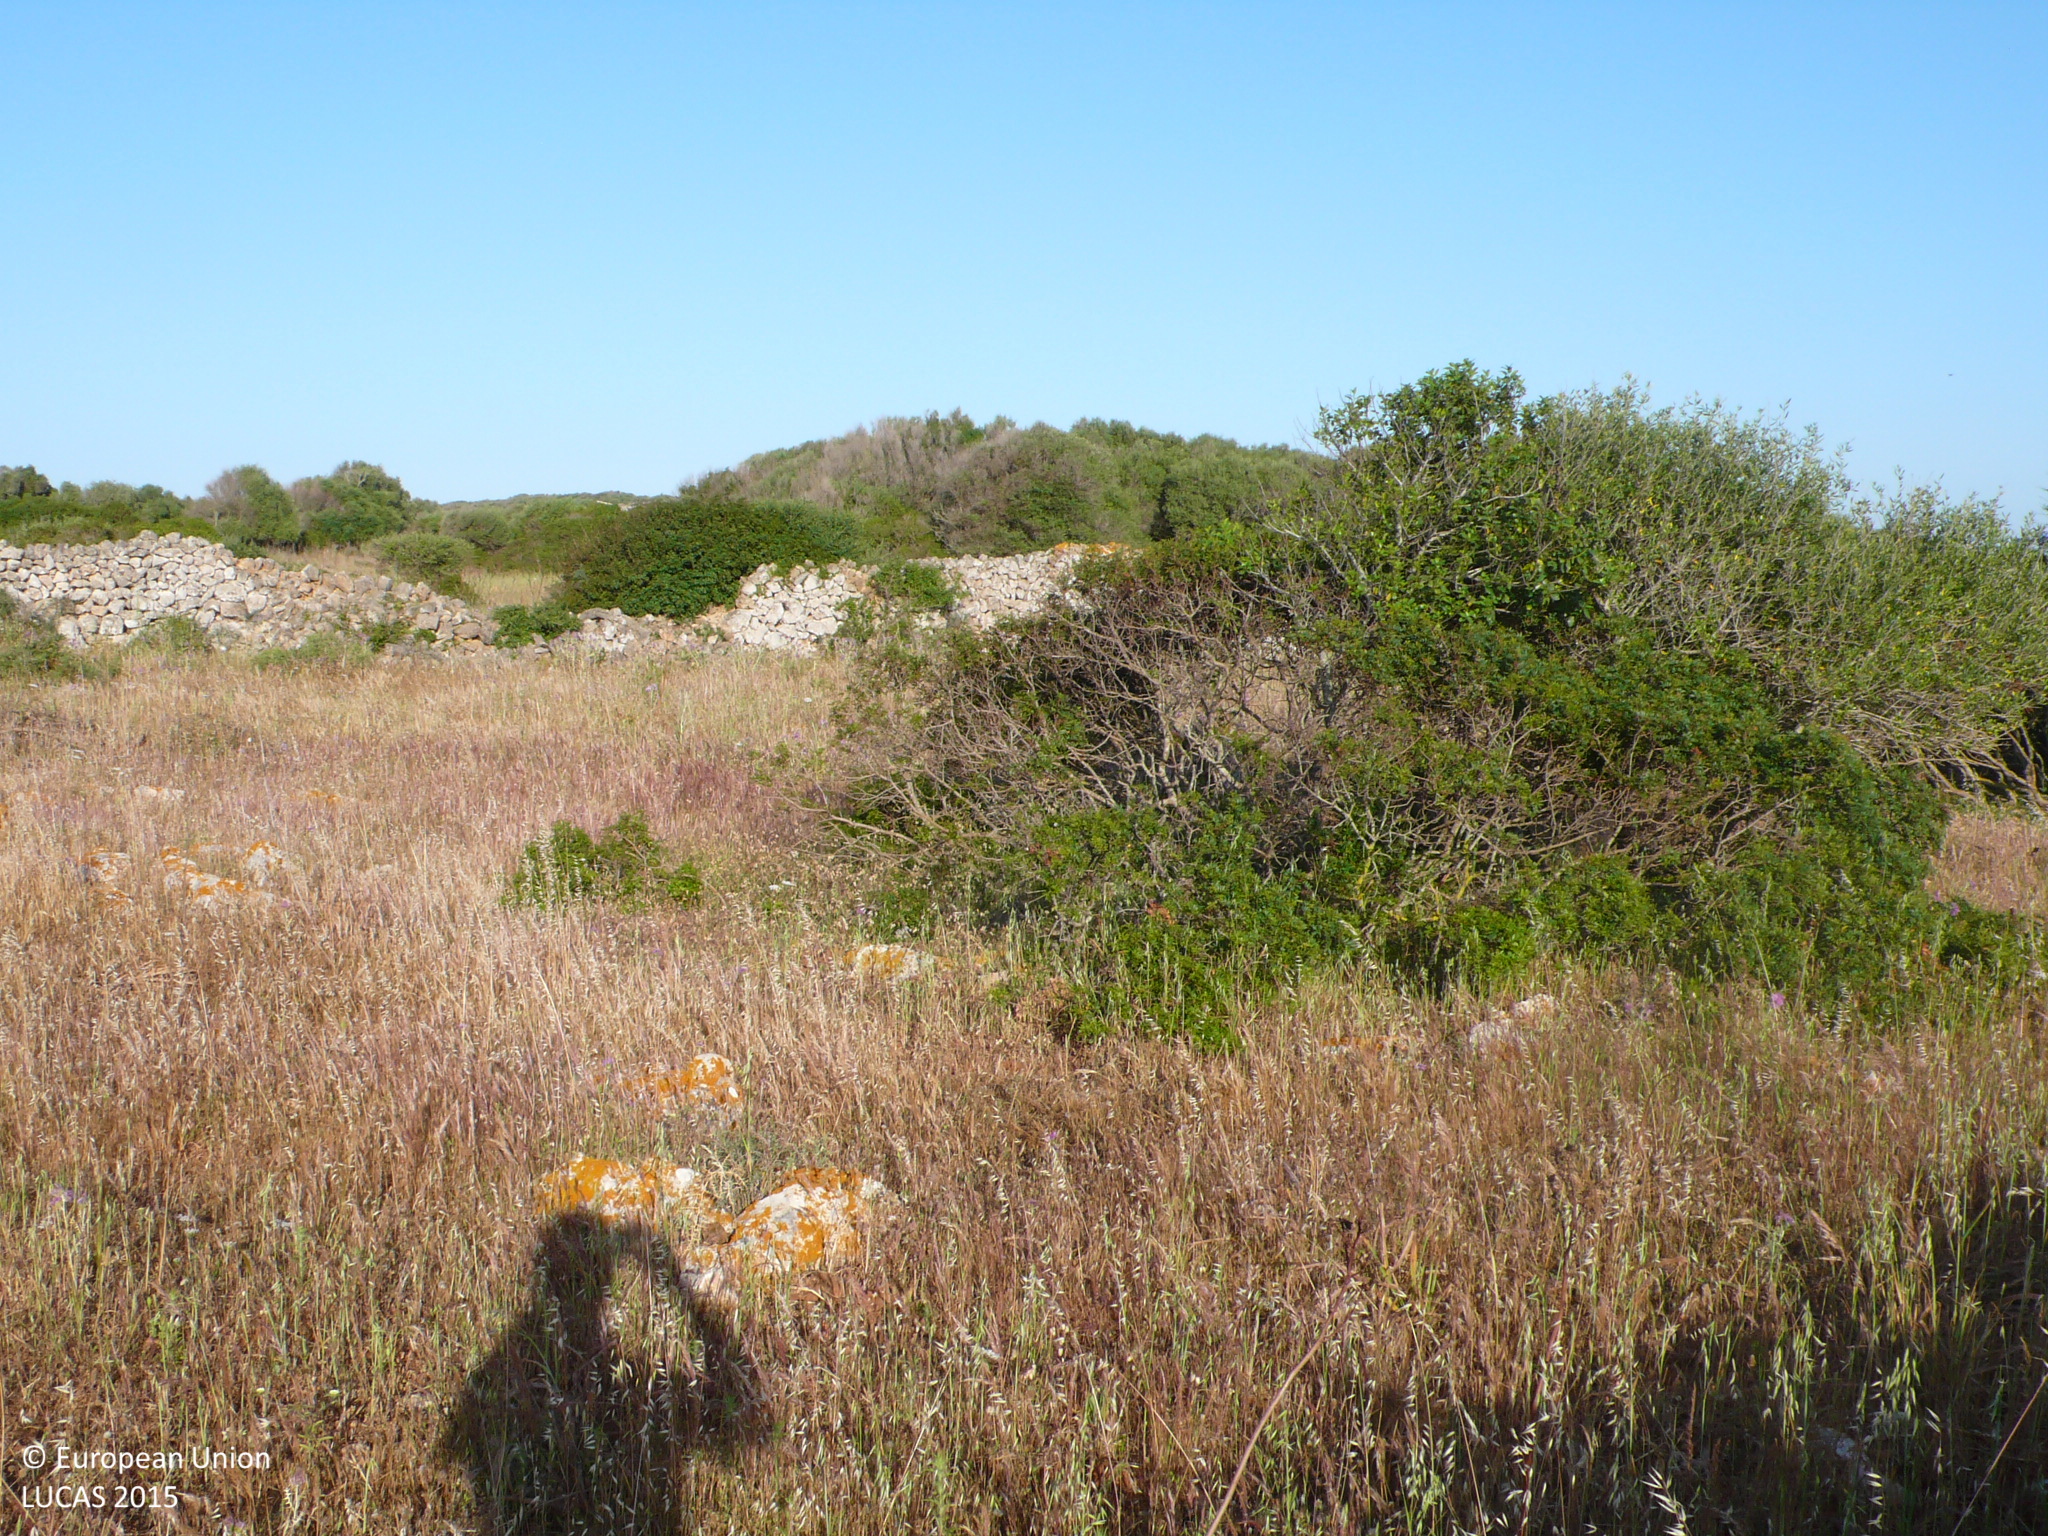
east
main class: Shrubland
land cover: Shrubland with sparse tree cover
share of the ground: 25 - 50 %
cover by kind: herbaceous plants 70 %, shrubs 25 %, broadleaved forest trees 5 %
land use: Semi-natural and natural areas not in use
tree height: < 5 m
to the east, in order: Shrubland with sparse tree cover; Dry stone walls; Single bushes/trees; Shrubland without tree cover; Dry stone walls; Abandoned hedges; Shrubland with sparse tree cover; Dry stone walls; Broadleaved woodland; Dry stone walls; Abandoned hedges
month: May
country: ES
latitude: 39.8941
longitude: 4.1670
